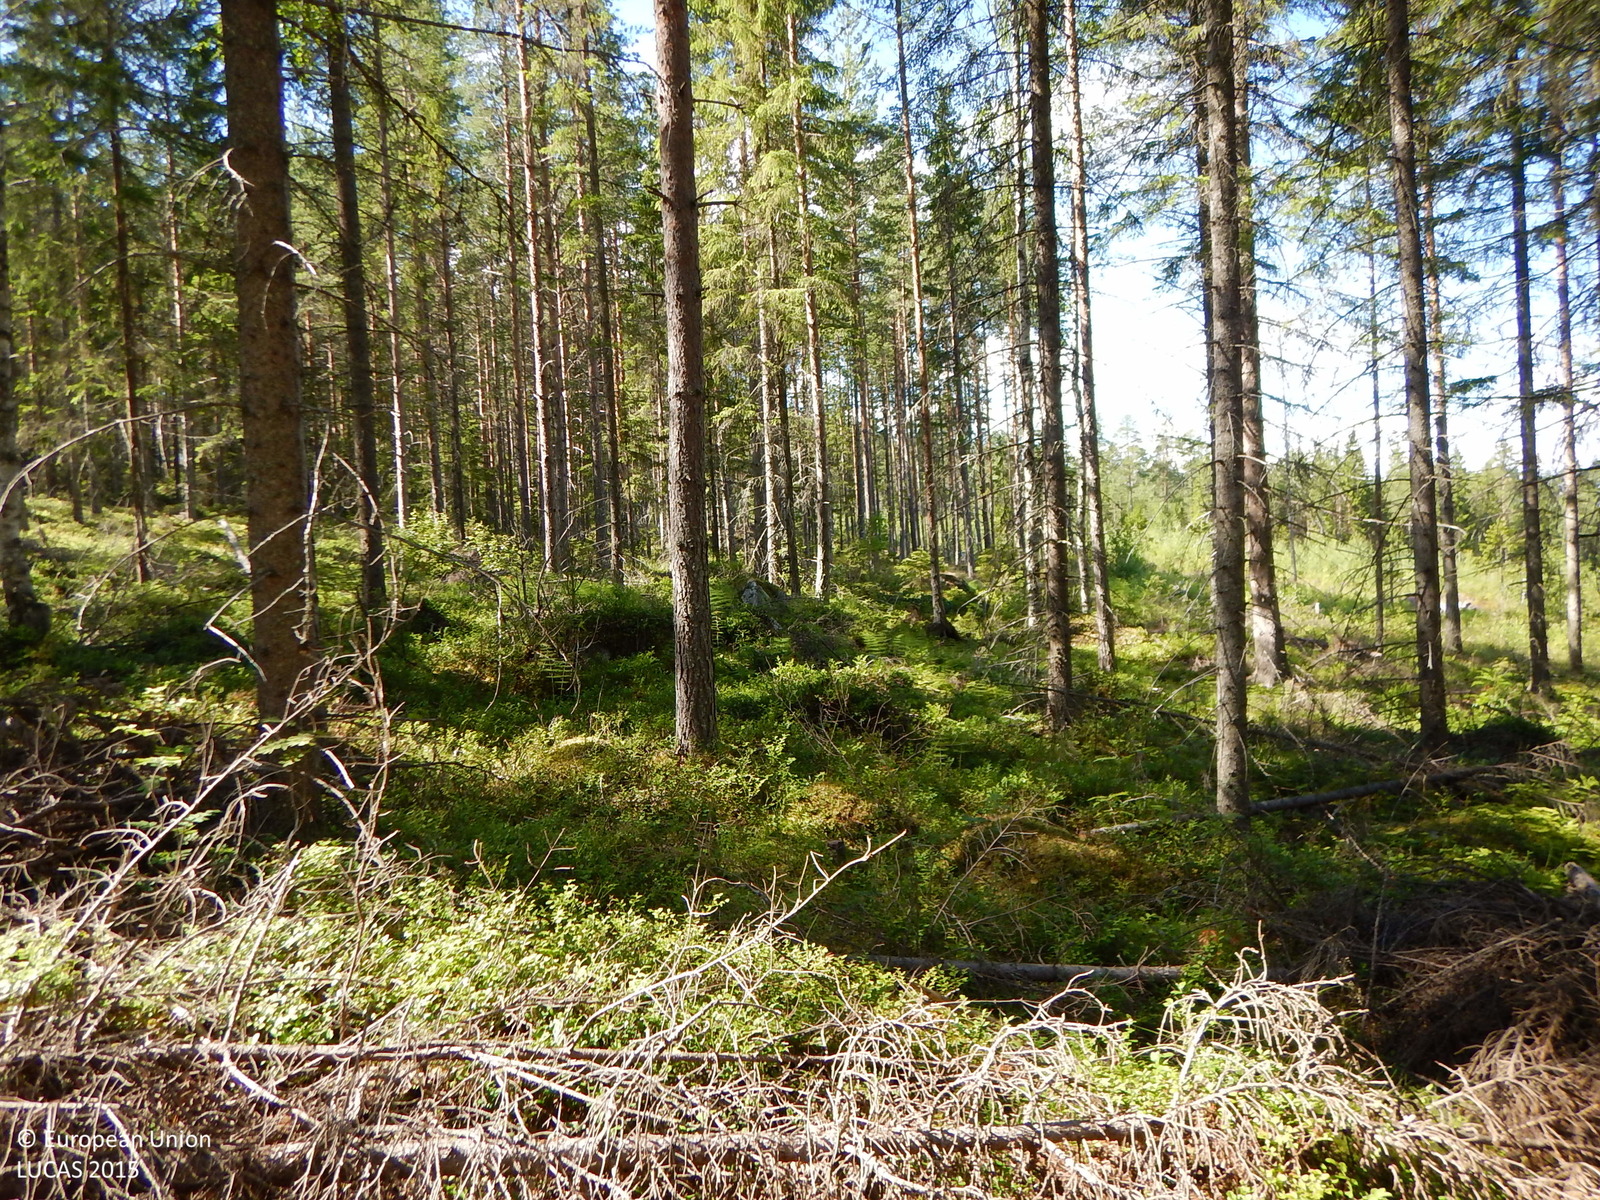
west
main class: Woodland
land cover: Spruce dominated coniferous woodland
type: boreal forest
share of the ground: 50 - 75 %
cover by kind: coniferous forest trees 50 %, shrubs 15 %, herbaceous plants 15 %, broadleaved forest trees 10 %, lichens and mosses 10 %
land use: Forestry
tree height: > 5 m
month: July
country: SE
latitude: 64.8164
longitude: 21.0356
